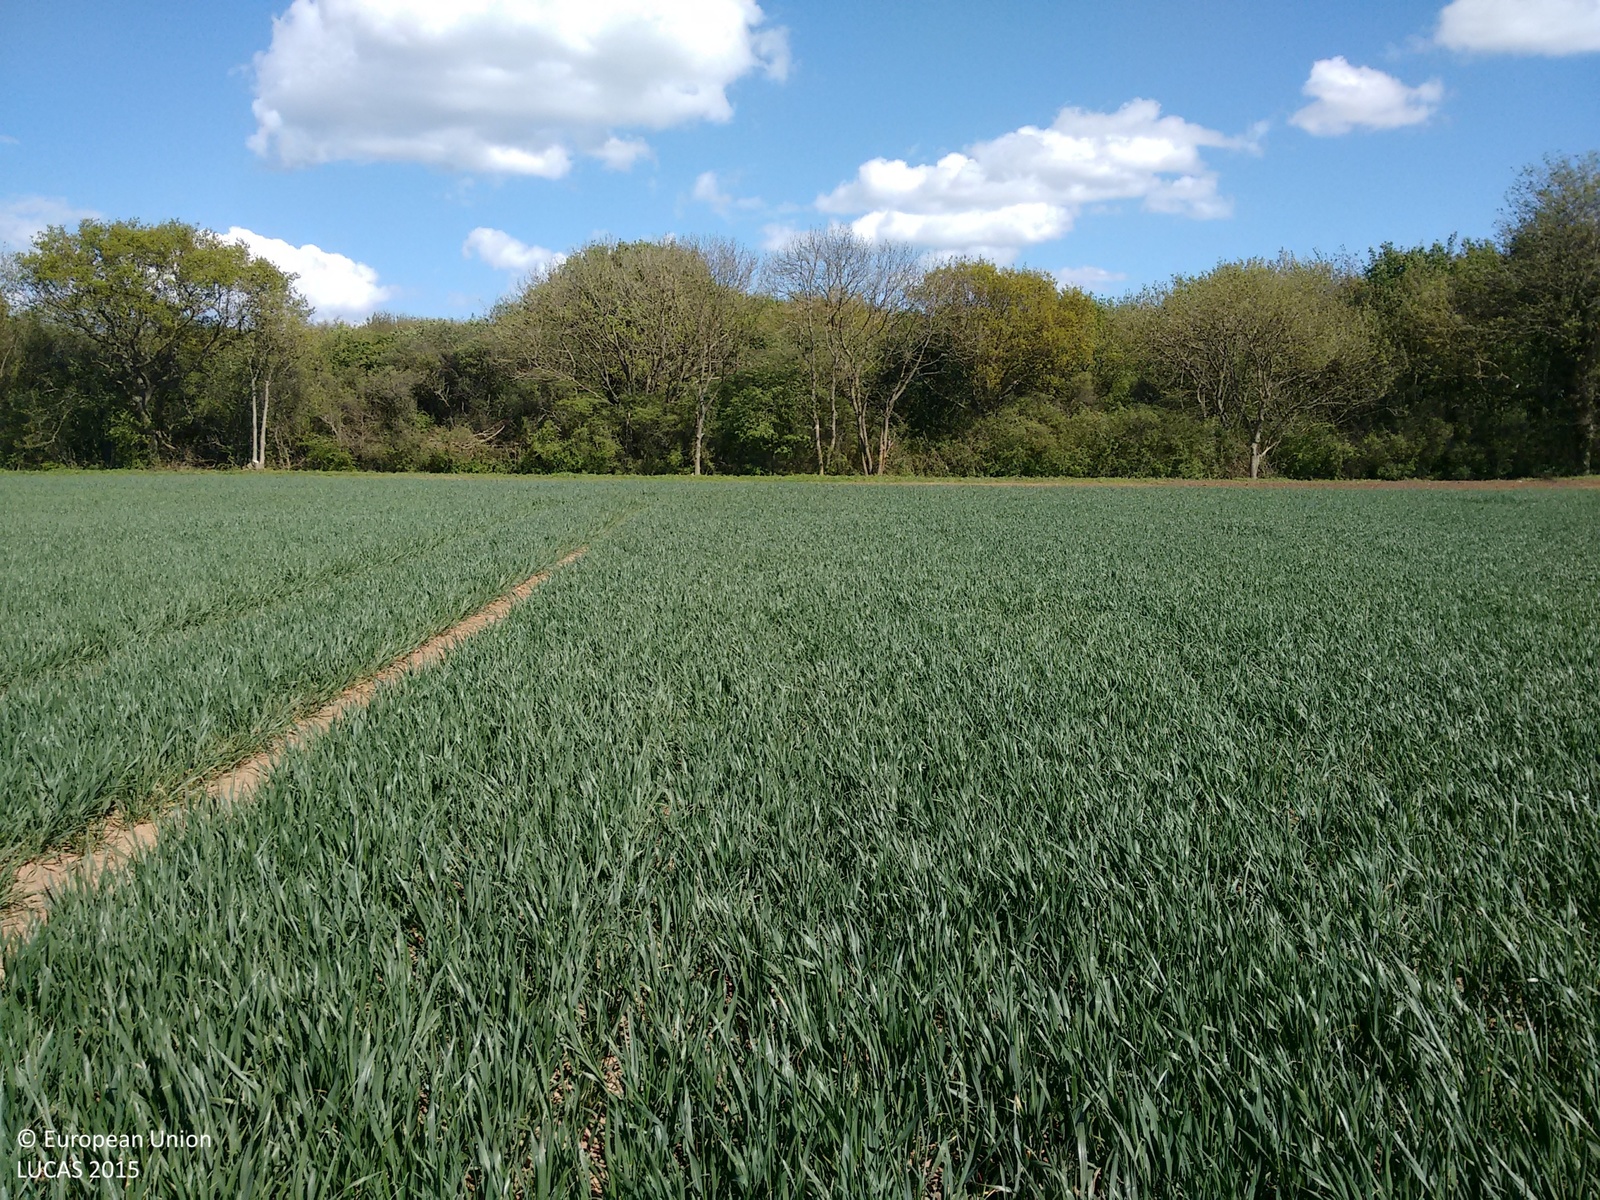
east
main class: Cropland
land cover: Common wheat
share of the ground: > 75 %
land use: Agriculture (excluding fallow land and kitchen gardens)
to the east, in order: Common wheat; Tracks; Grass margins; Ditches and canals; Broadleaved woodland
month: May
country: GB
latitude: 53.8706
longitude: -0.2694
